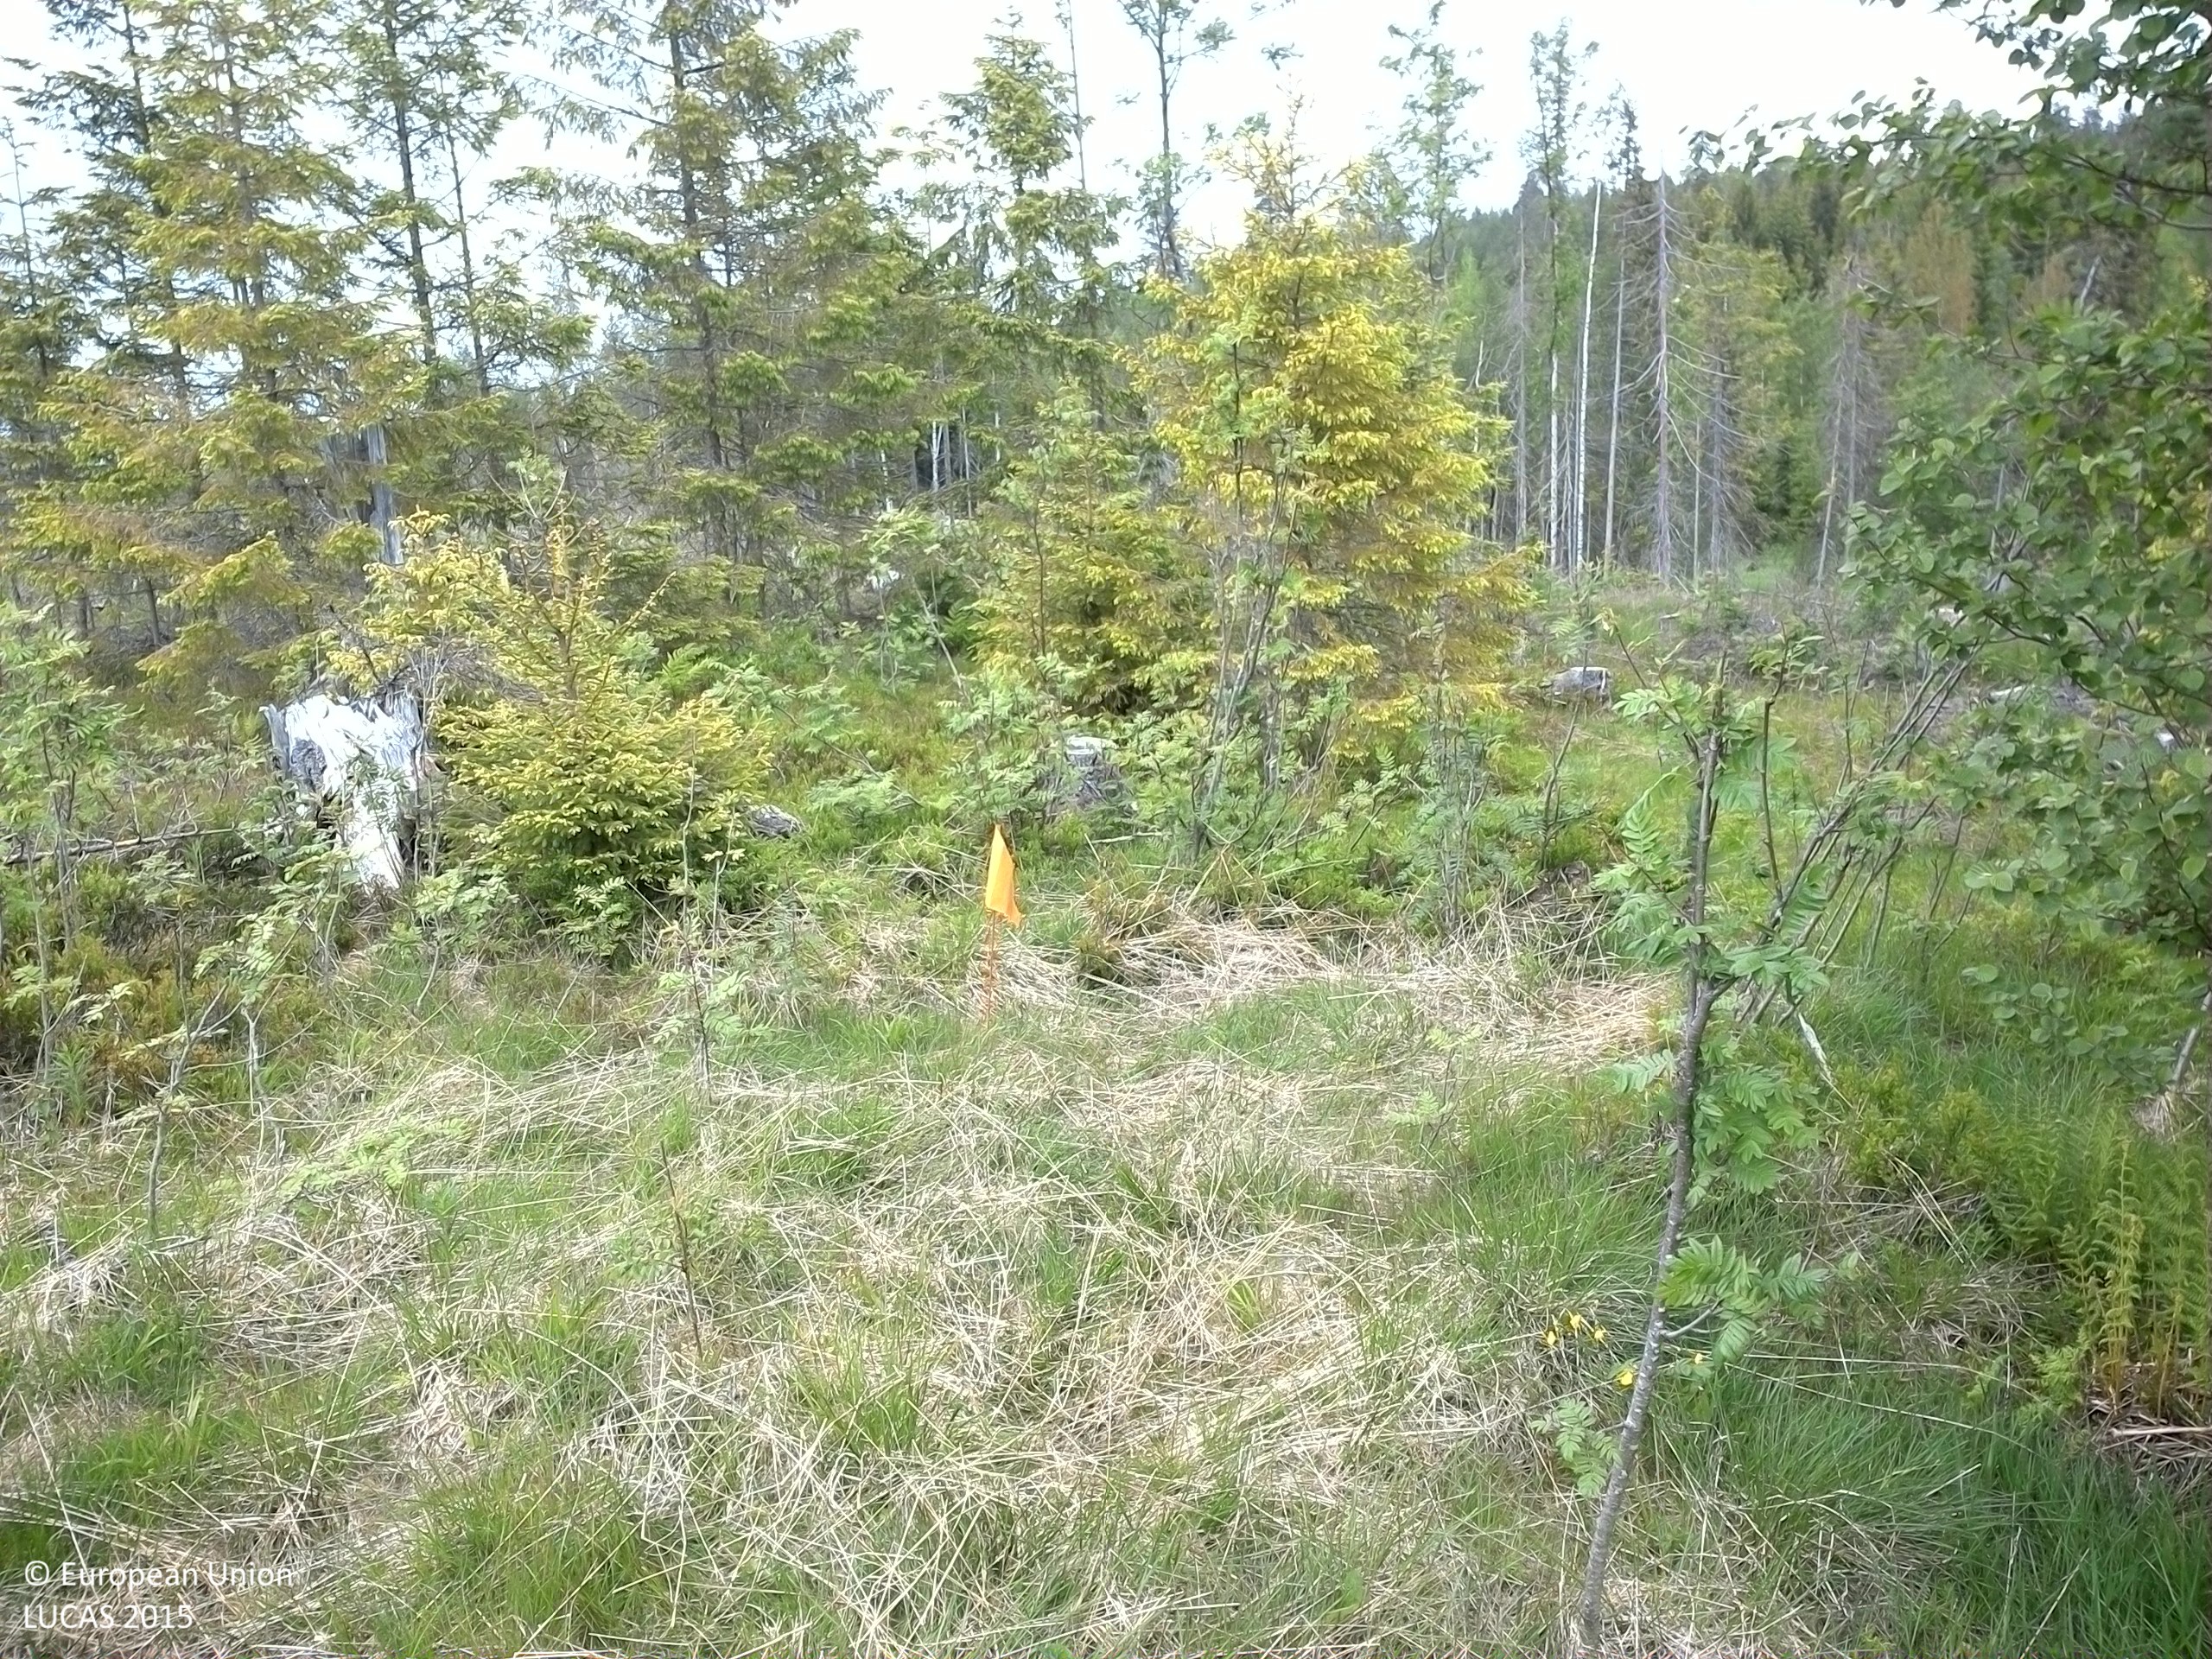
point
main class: Woodland
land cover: Spruce dominated mixed woodland
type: boreal forest
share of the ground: 10 - 25 %
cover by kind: herbaceous plants 65 %, coniferous forest trees 15 %, broadleaved forest trees 10 %, shrubs 10 %
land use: Forestry
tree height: < 5 m
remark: Clear cut
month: June
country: SE
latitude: 62.7033
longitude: 17.7390
